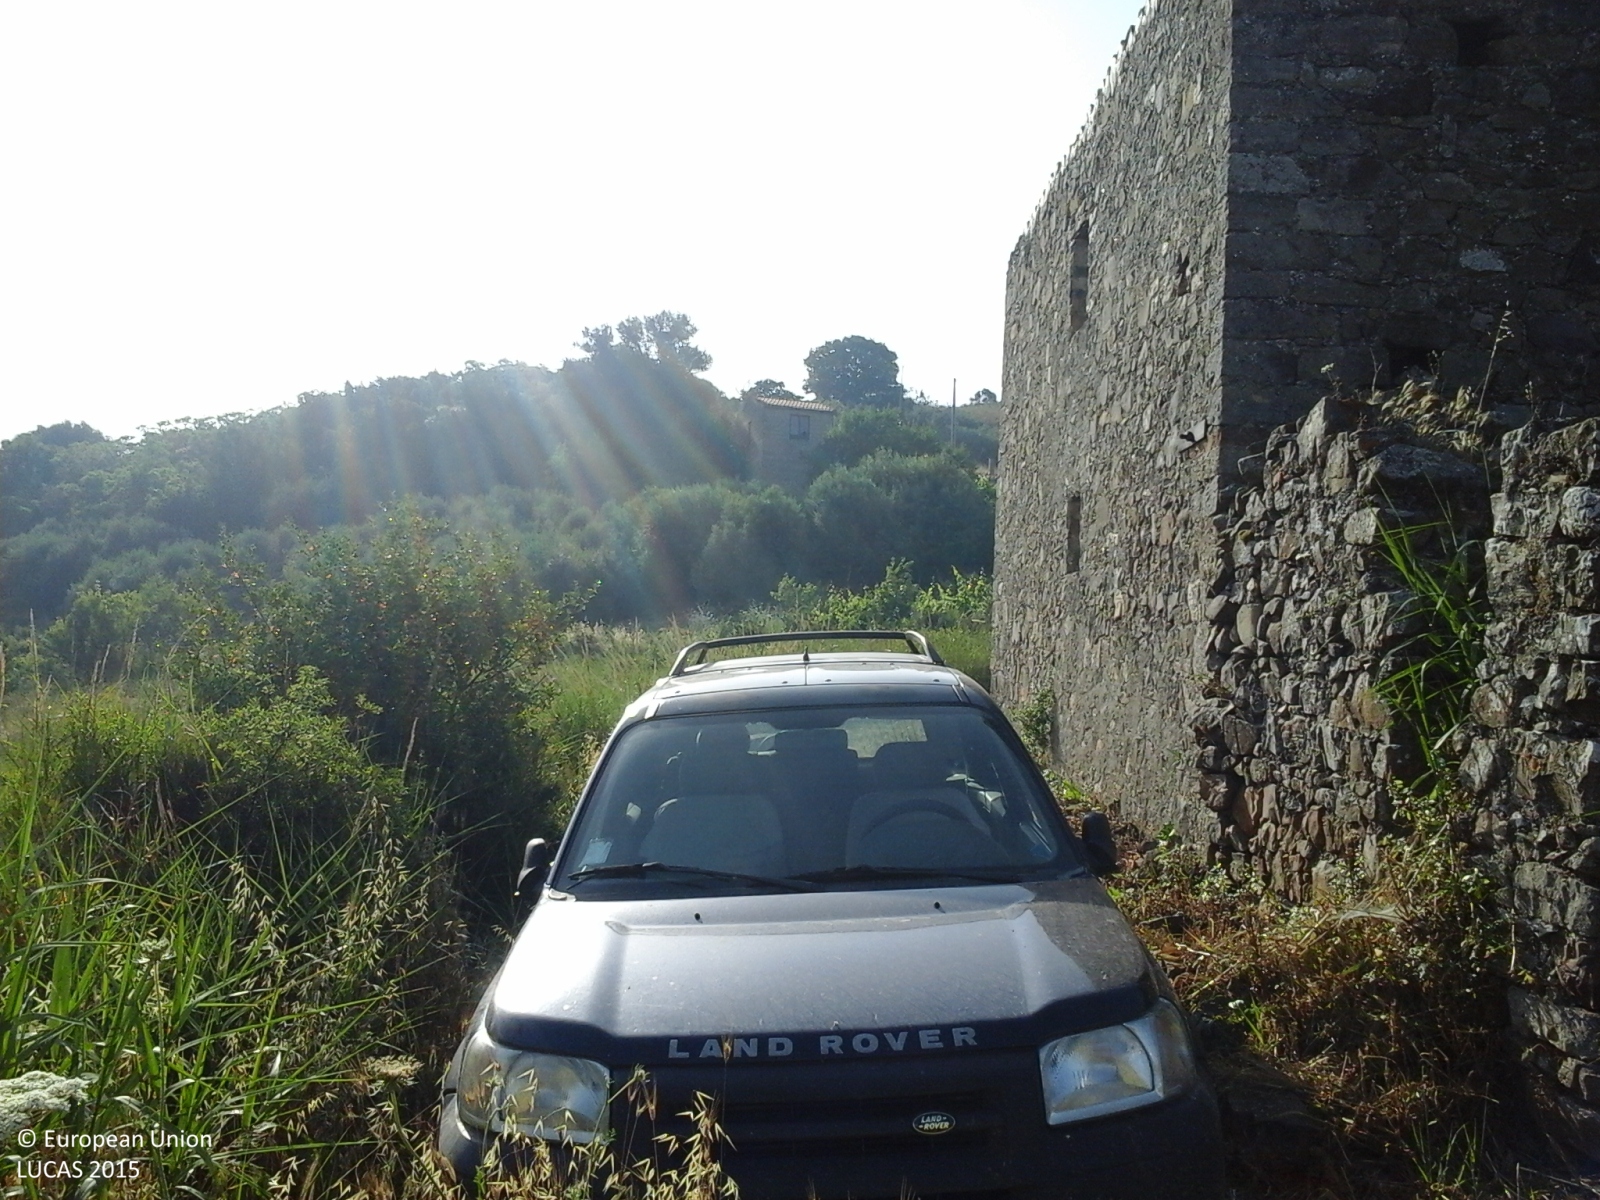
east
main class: Grassland
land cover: Spontaneously vegetated surfaces
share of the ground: > 75 %
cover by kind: herbaceous plants 100 %
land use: Fallow land
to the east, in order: Spontaneously vegetated surfaces; Artificial constructions in urban areas; Spontaneously vegetated surfaces; Fences; Tracks; Fences; Shrubland without tree cover; Fences; Permanent crops (only in case pi); Shrubland without tree cover; Tracks; Shrubland with sparse tree cover; Permanent crops (only in case pi)
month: June
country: IT
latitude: 37.8124
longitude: 13.9135
